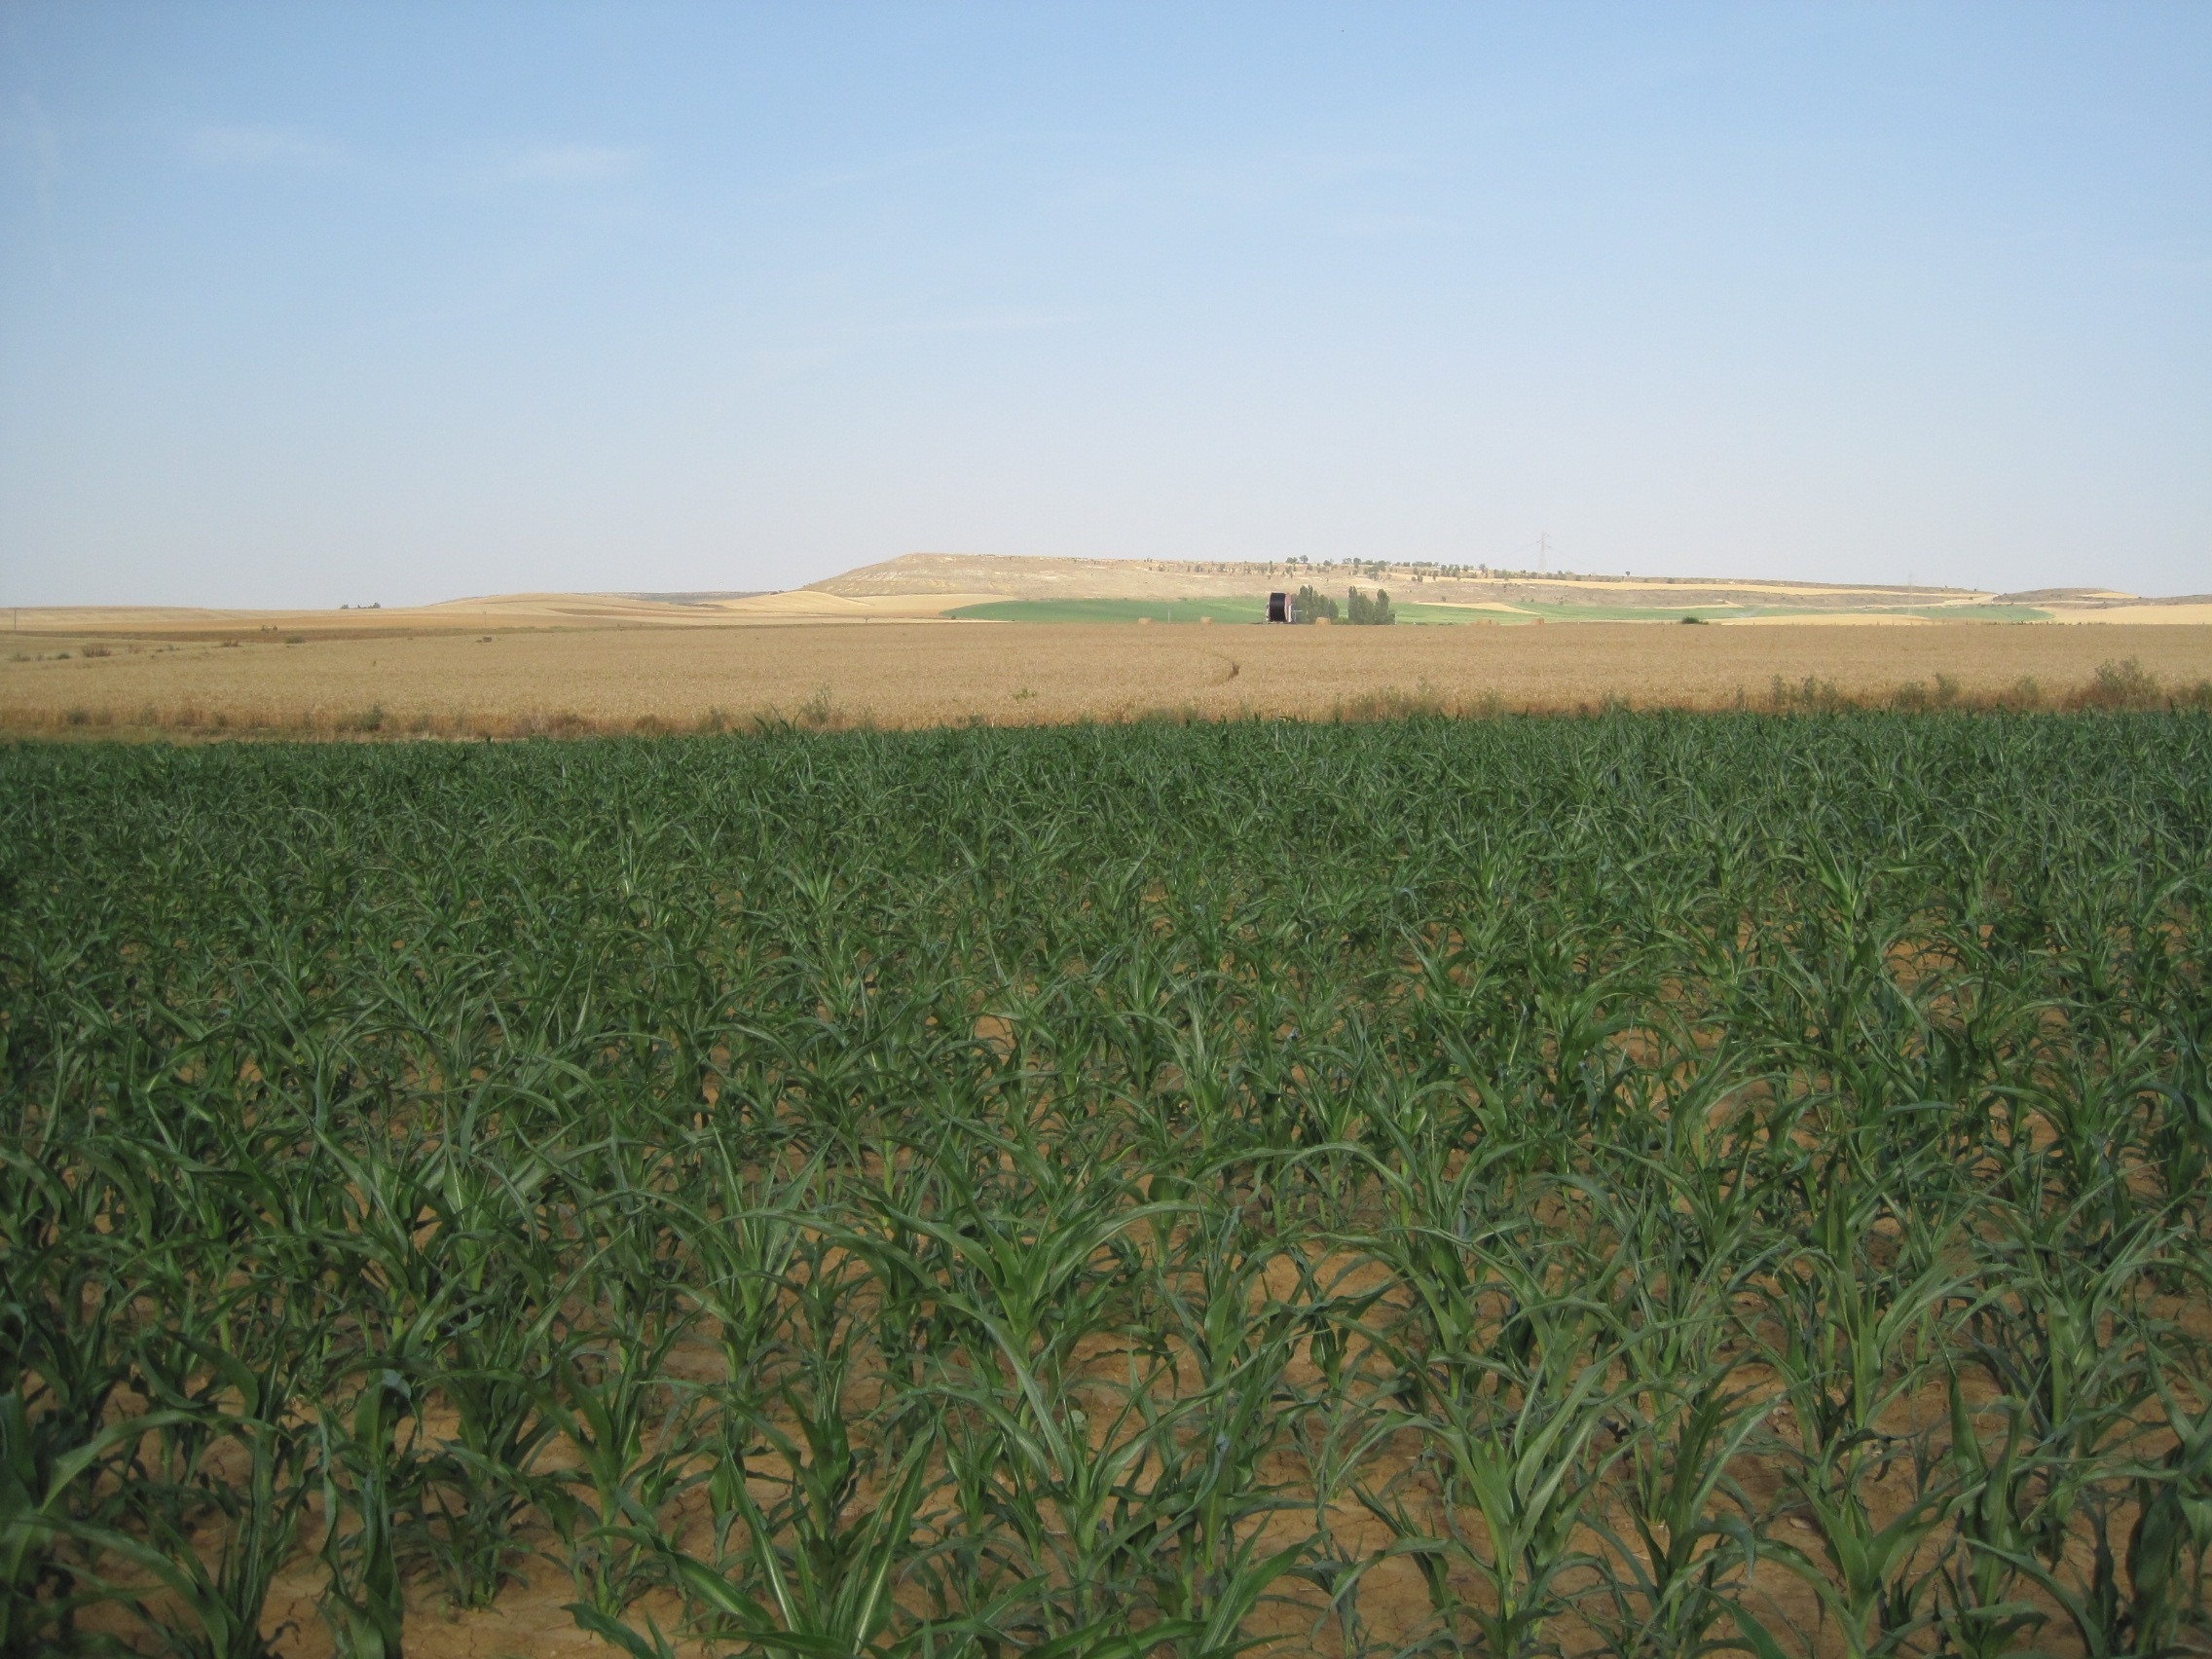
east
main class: Cropland
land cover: Maize
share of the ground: > 75 %
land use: Agriculture (excluding fallow land and kitchen gardens)
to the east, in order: Maize; Grass margins; Tracks; Grass margins; Common wheat; Grass margins; Barley
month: July
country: ES
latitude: 41.6780
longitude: -5.3487
